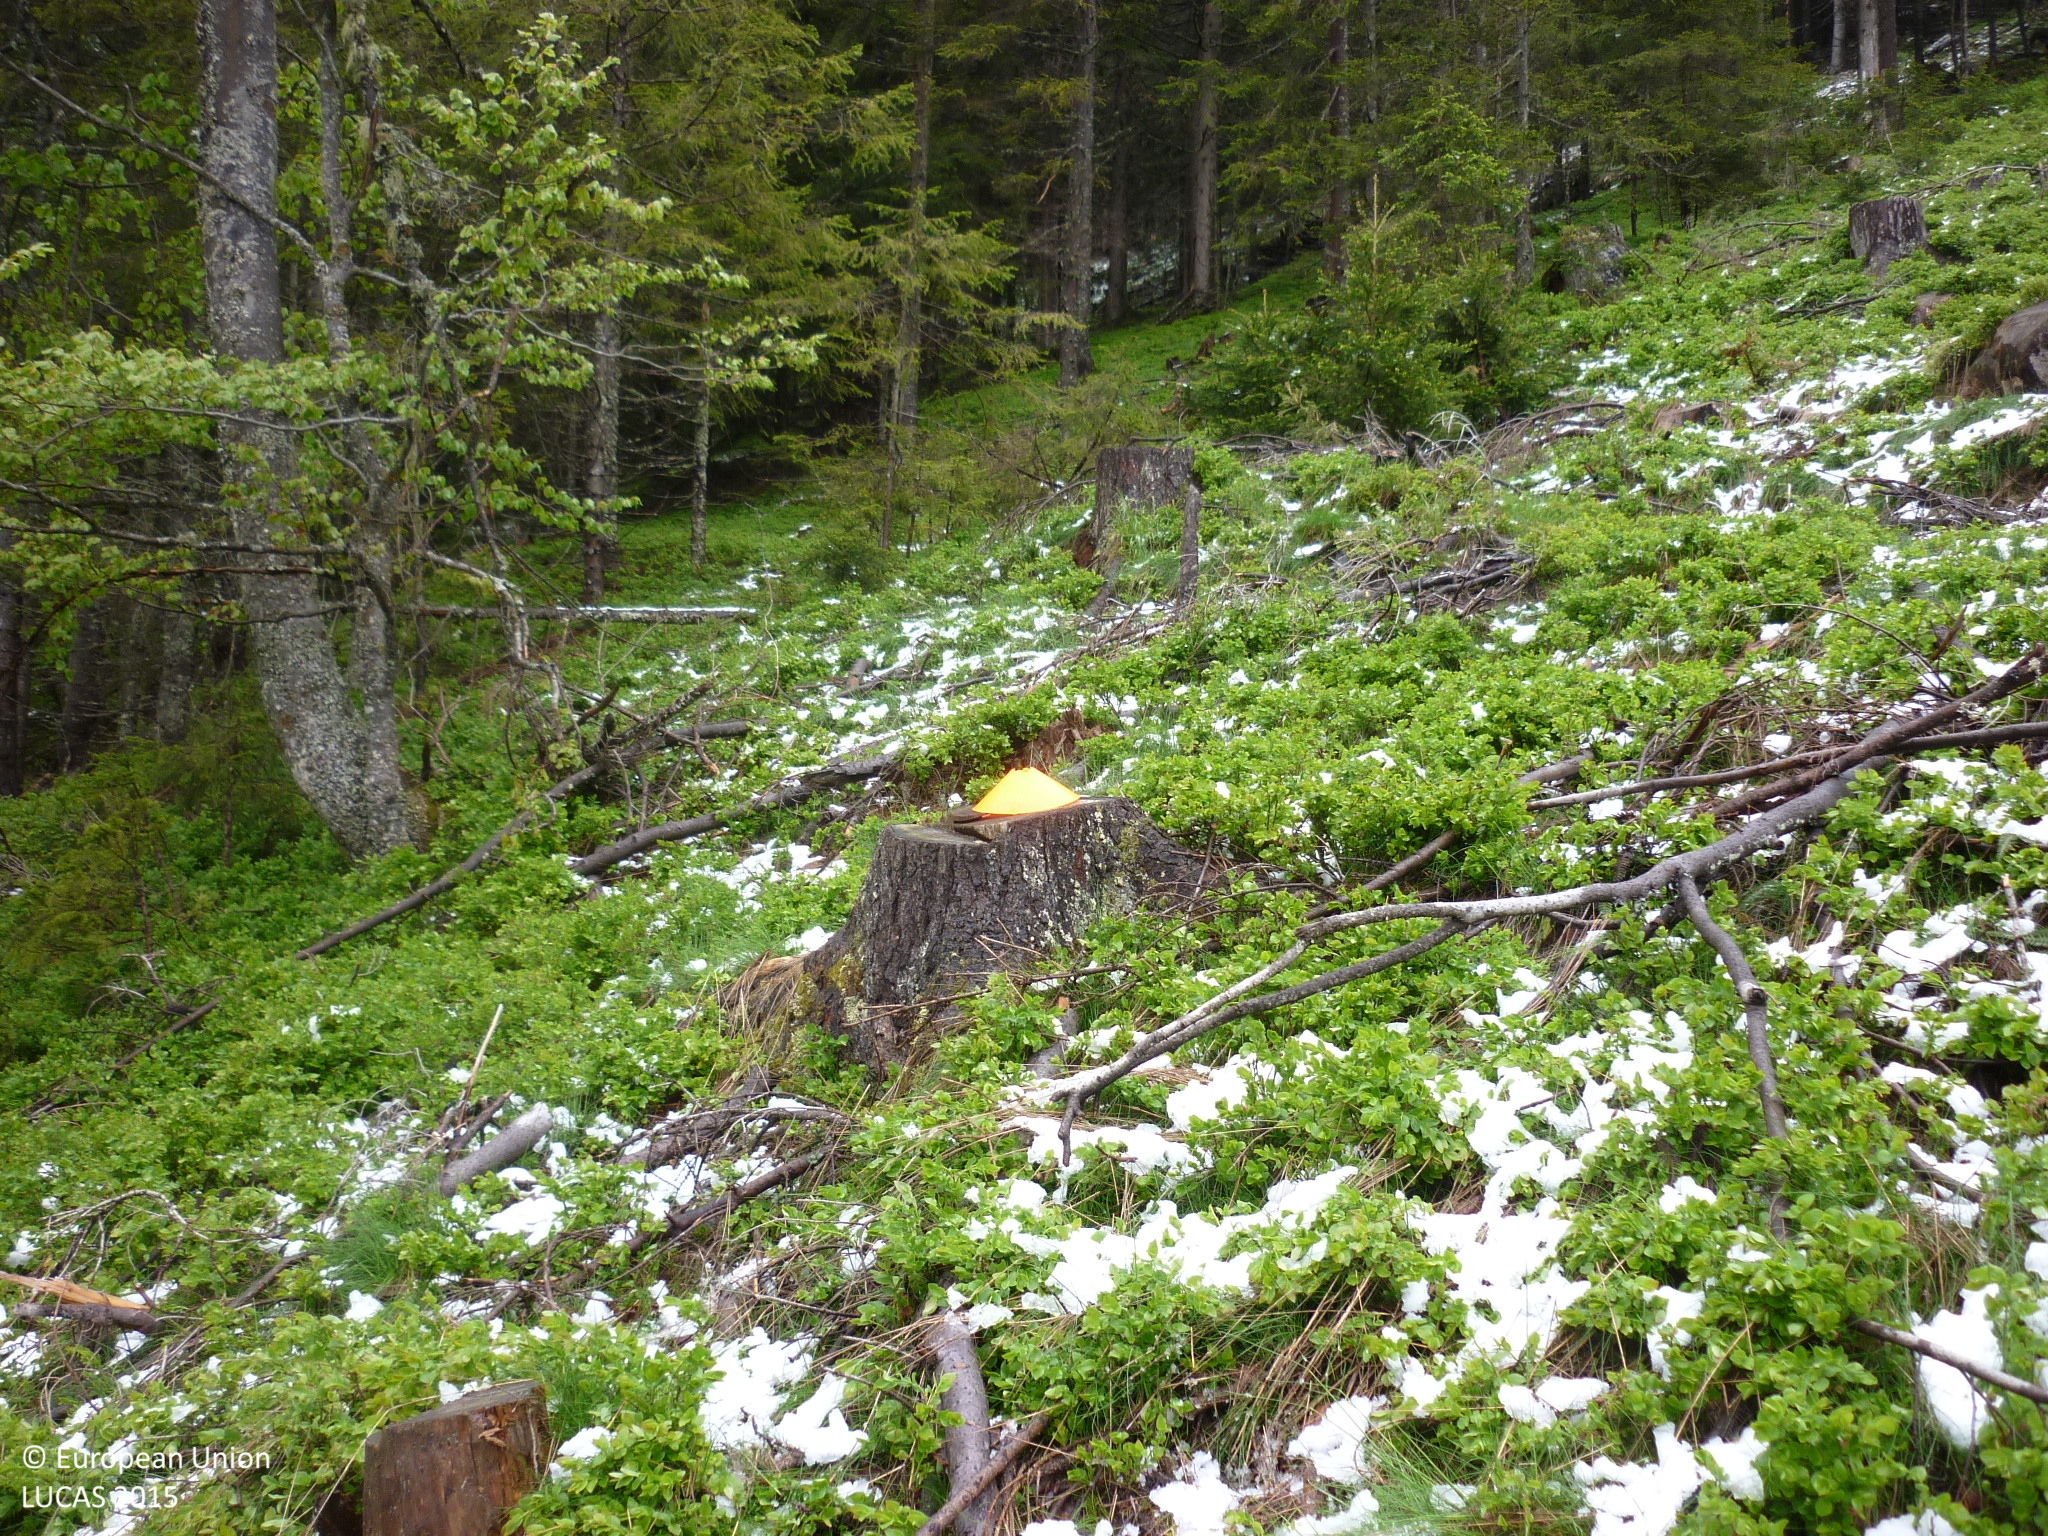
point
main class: Shrubland
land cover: Shrubland with sparse tree cover
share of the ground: > 75 %
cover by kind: shrubs 80 %, herbaceous plants 15 %, coniferous forest trees 5 %
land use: Forestry
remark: Clear cut
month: May
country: AT
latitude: 47.4459
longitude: 14.5213
